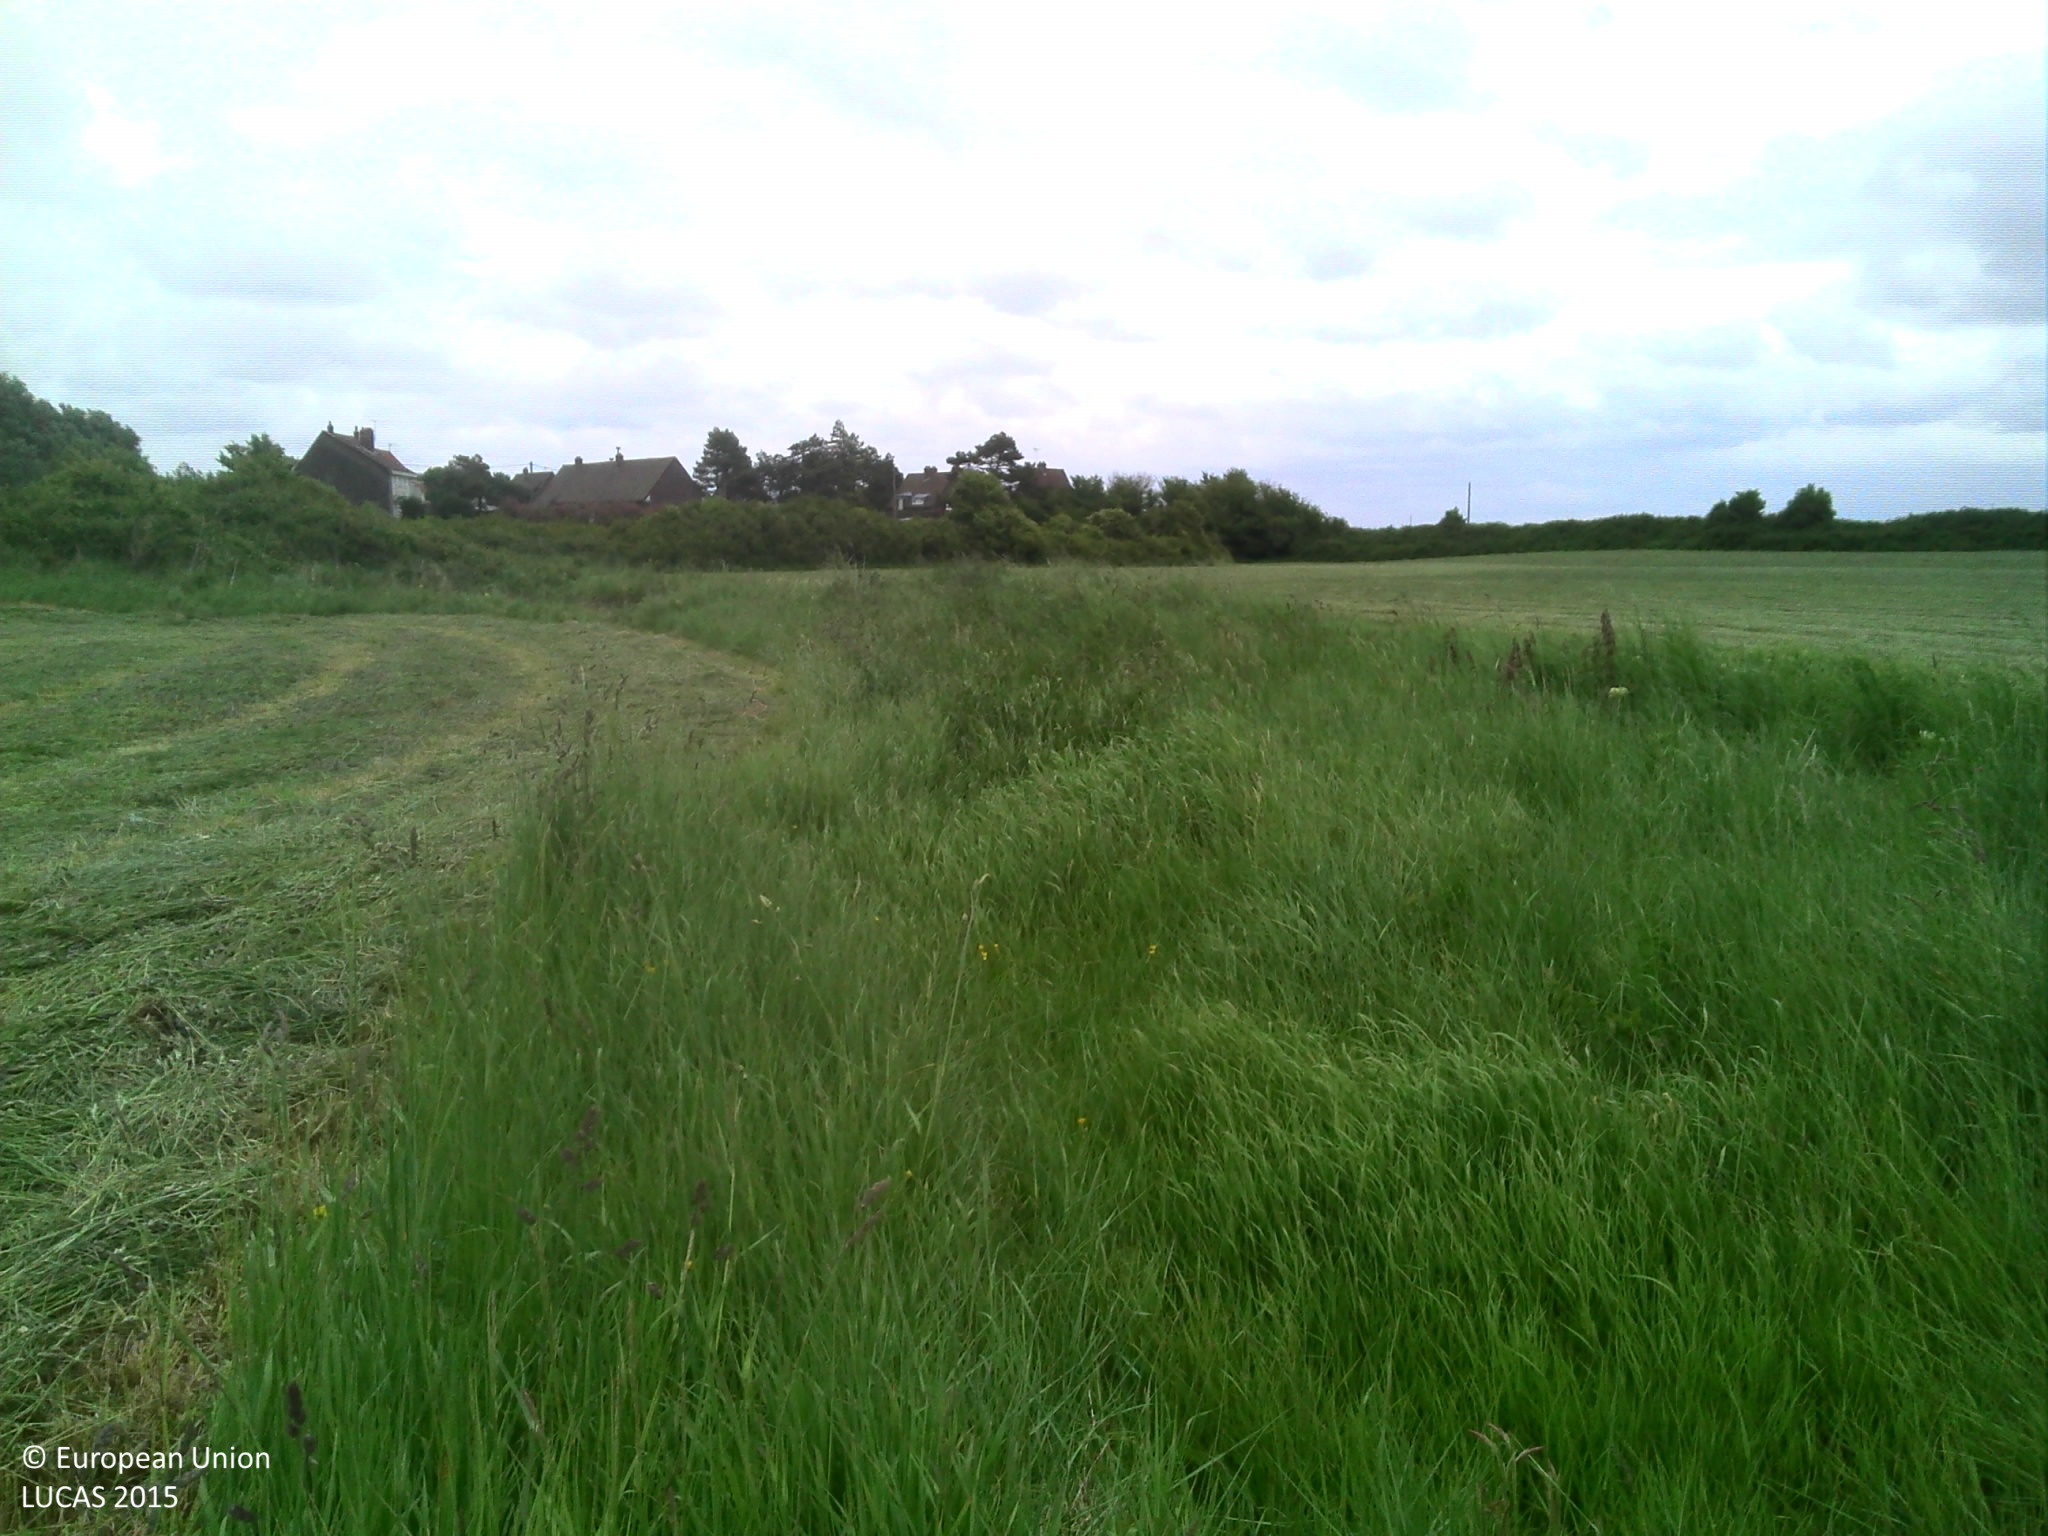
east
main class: Grassland
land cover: Grassland without tree/shrub cover
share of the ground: > 75 %
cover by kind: herbaceous plants 100 %
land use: Agriculture (excluding fallow land and kitchen gardens)
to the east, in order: Grassland without tree/shrub cover; Ponds and wetlands; Grassland without tree/shrub cover; Fences; Shrubland with sparse tree cover; Rock outcrops; Grassland without tree/shrub cover; Managed hedges; Artificial constructions in urban areas
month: May
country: FR
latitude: 50.2144
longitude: 1.5591
